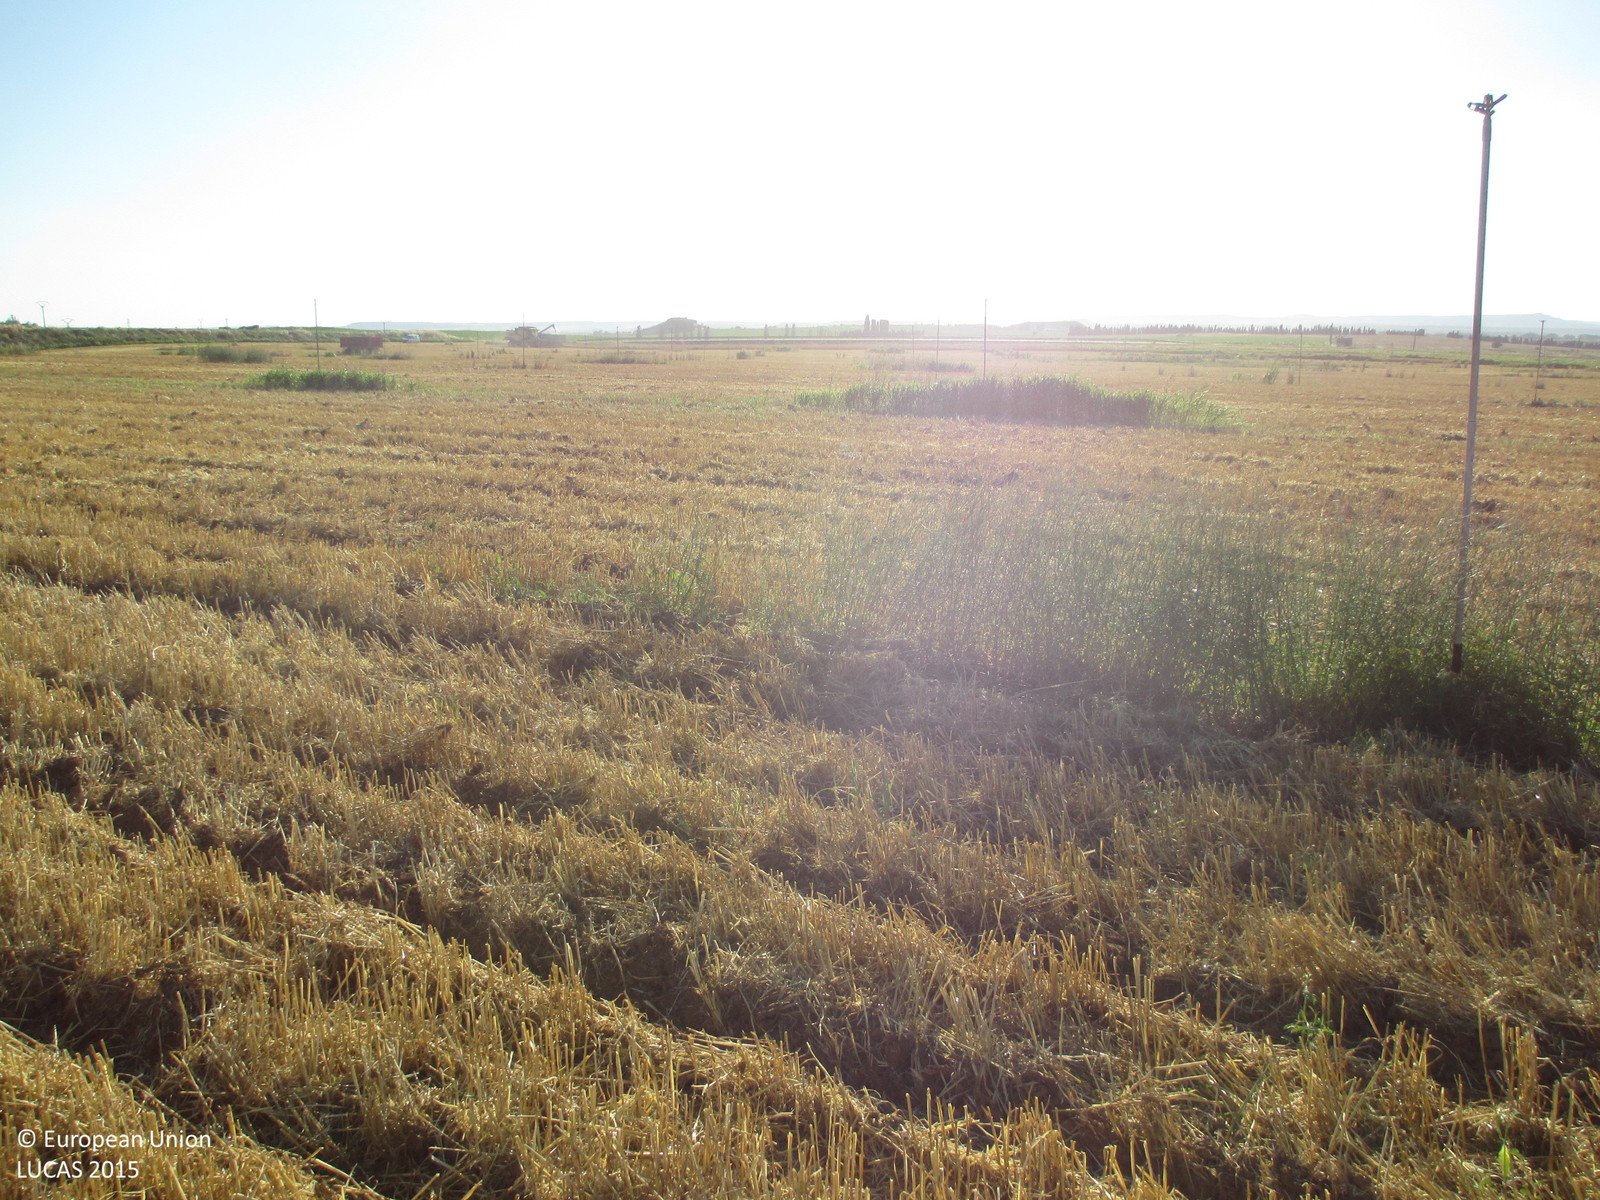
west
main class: Cropland
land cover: Sunflower
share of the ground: < 10 %
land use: Agriculture (excluding fallow land and kitchen gardens)
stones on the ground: < 10 %
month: June
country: ES
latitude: 42.0291
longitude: -0.3725
